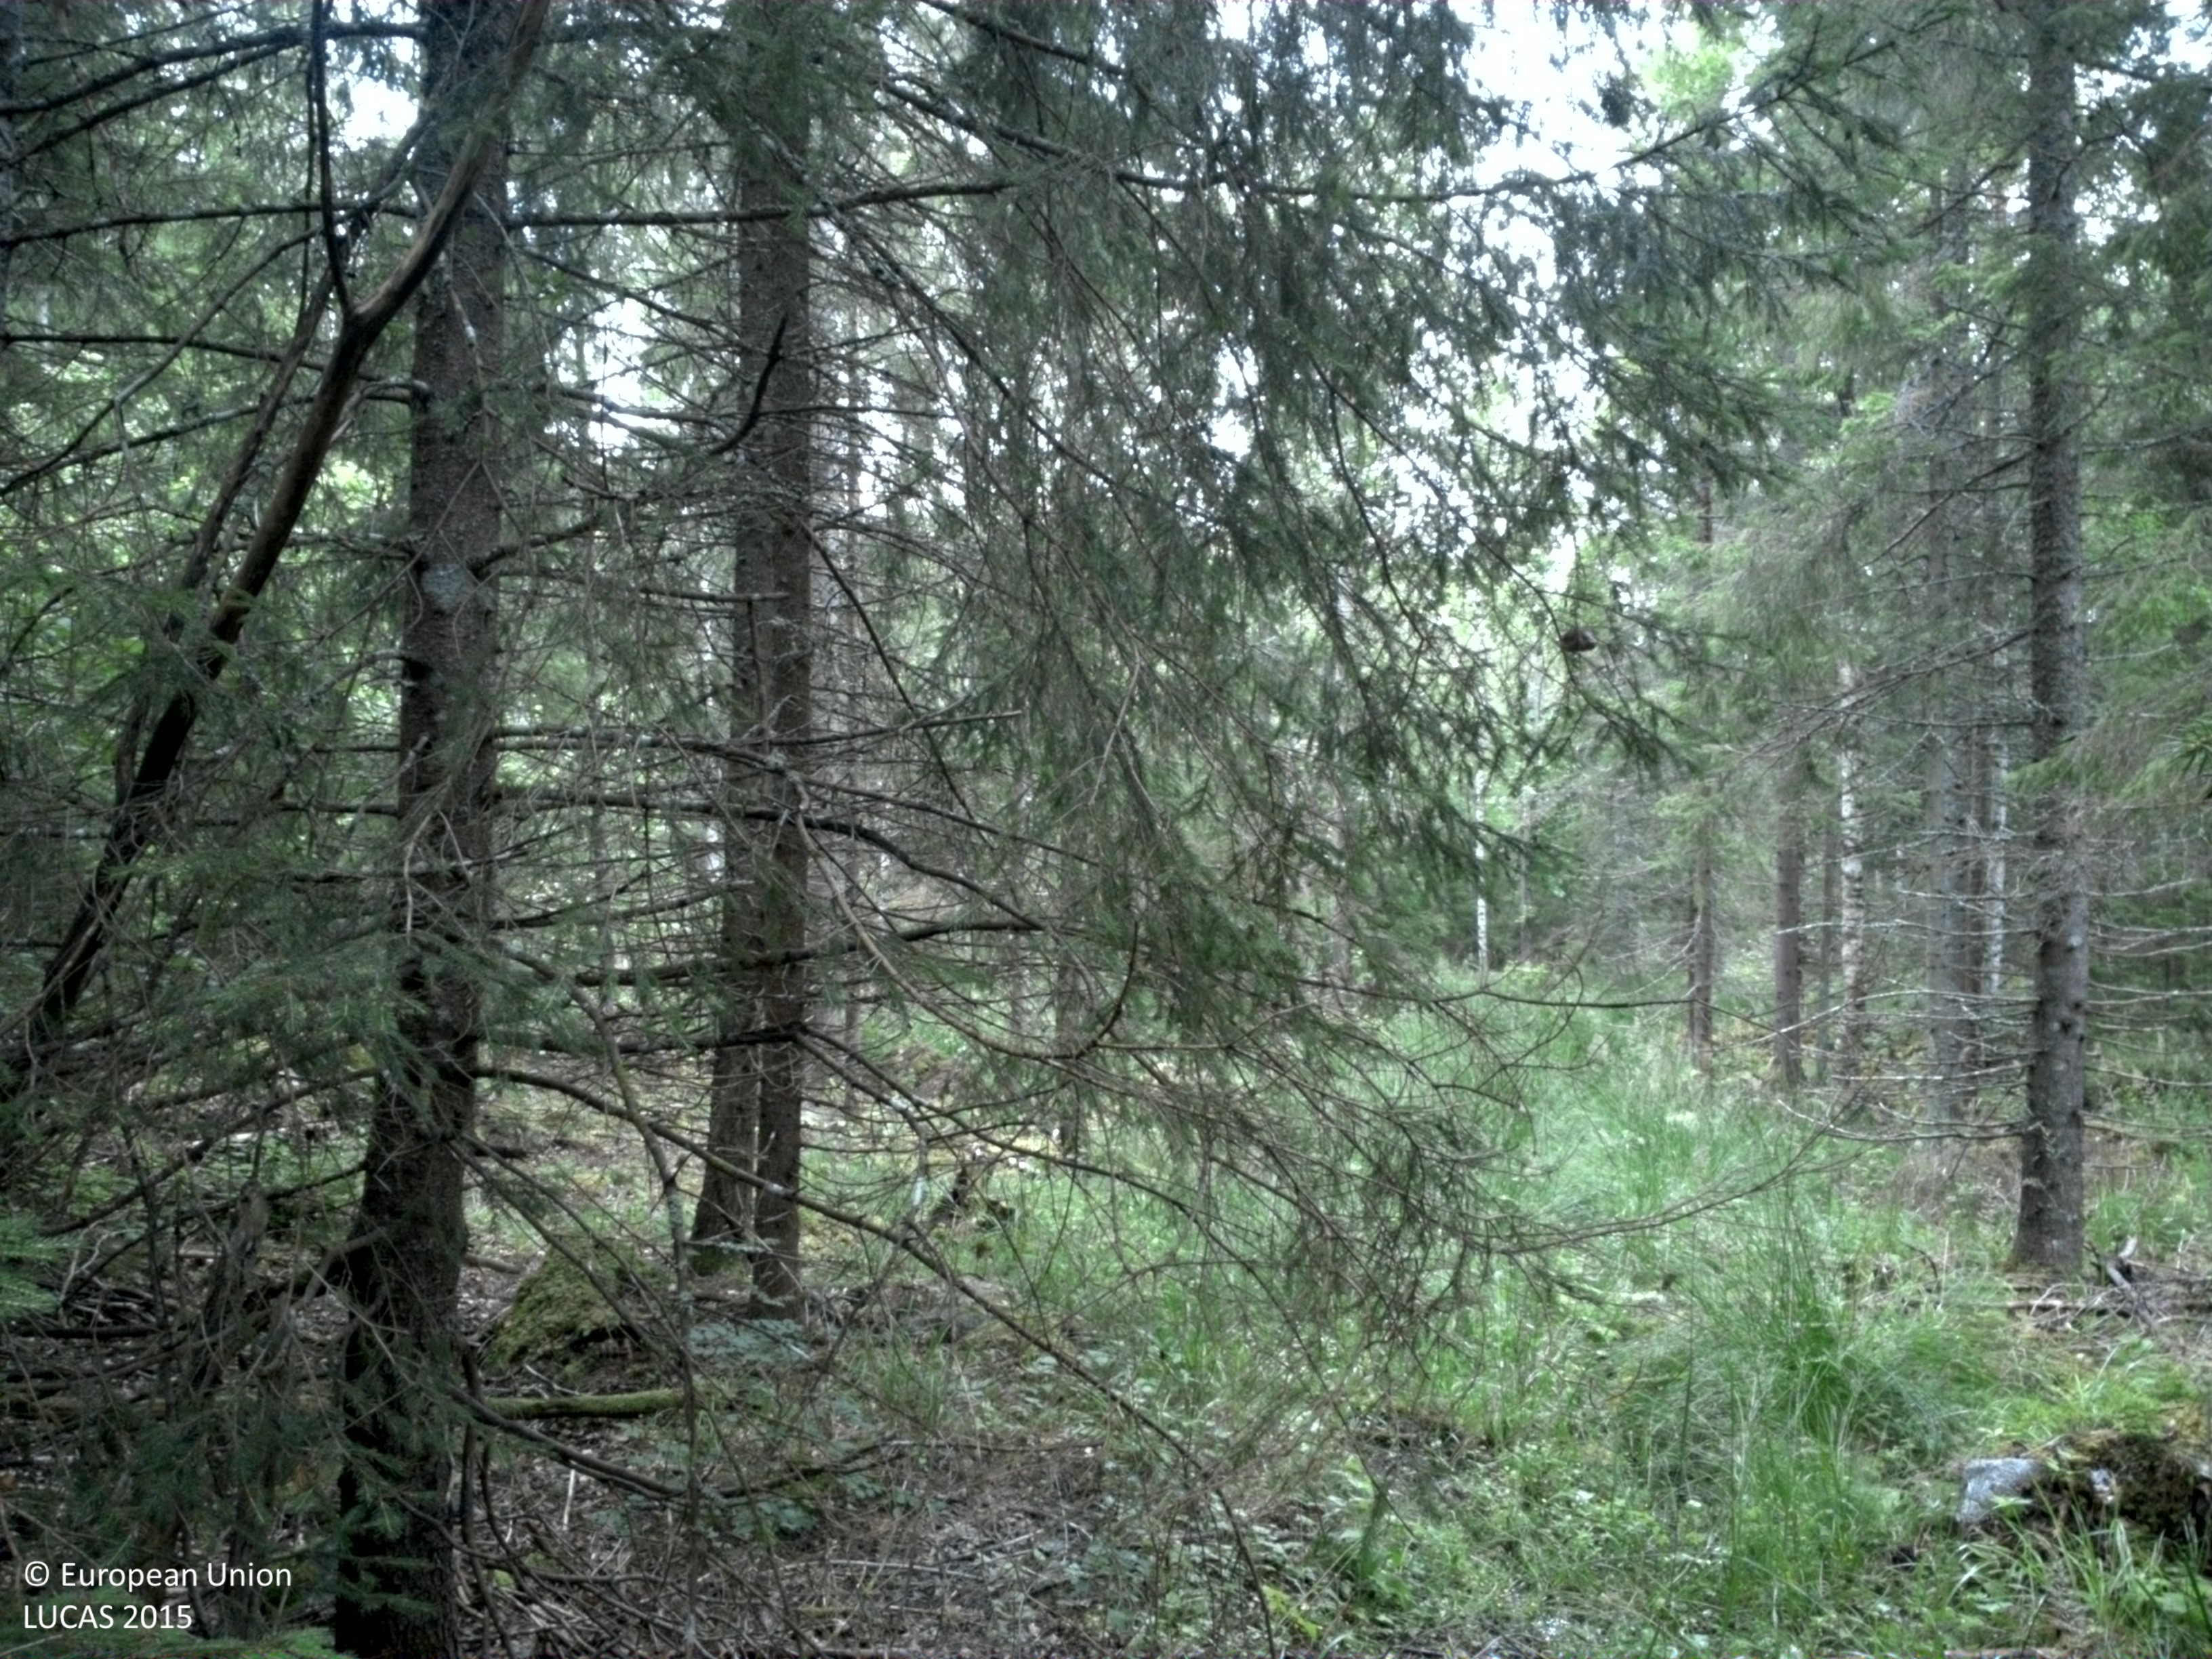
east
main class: Woodland
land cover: Spruce dominated coniferous woodland
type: boreal forest
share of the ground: > 75 %
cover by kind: coniferous forest trees 60 %, herbaceous plants 25 %, broadleaved forest trees 15 %
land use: Forestry
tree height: > 5 m
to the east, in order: Spruce dominated coniferous woodland; Spruce dominated mixed woodland; Spruce dominated coniferous woodland
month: July
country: SE
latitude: 59.8664
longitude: 18.5527
